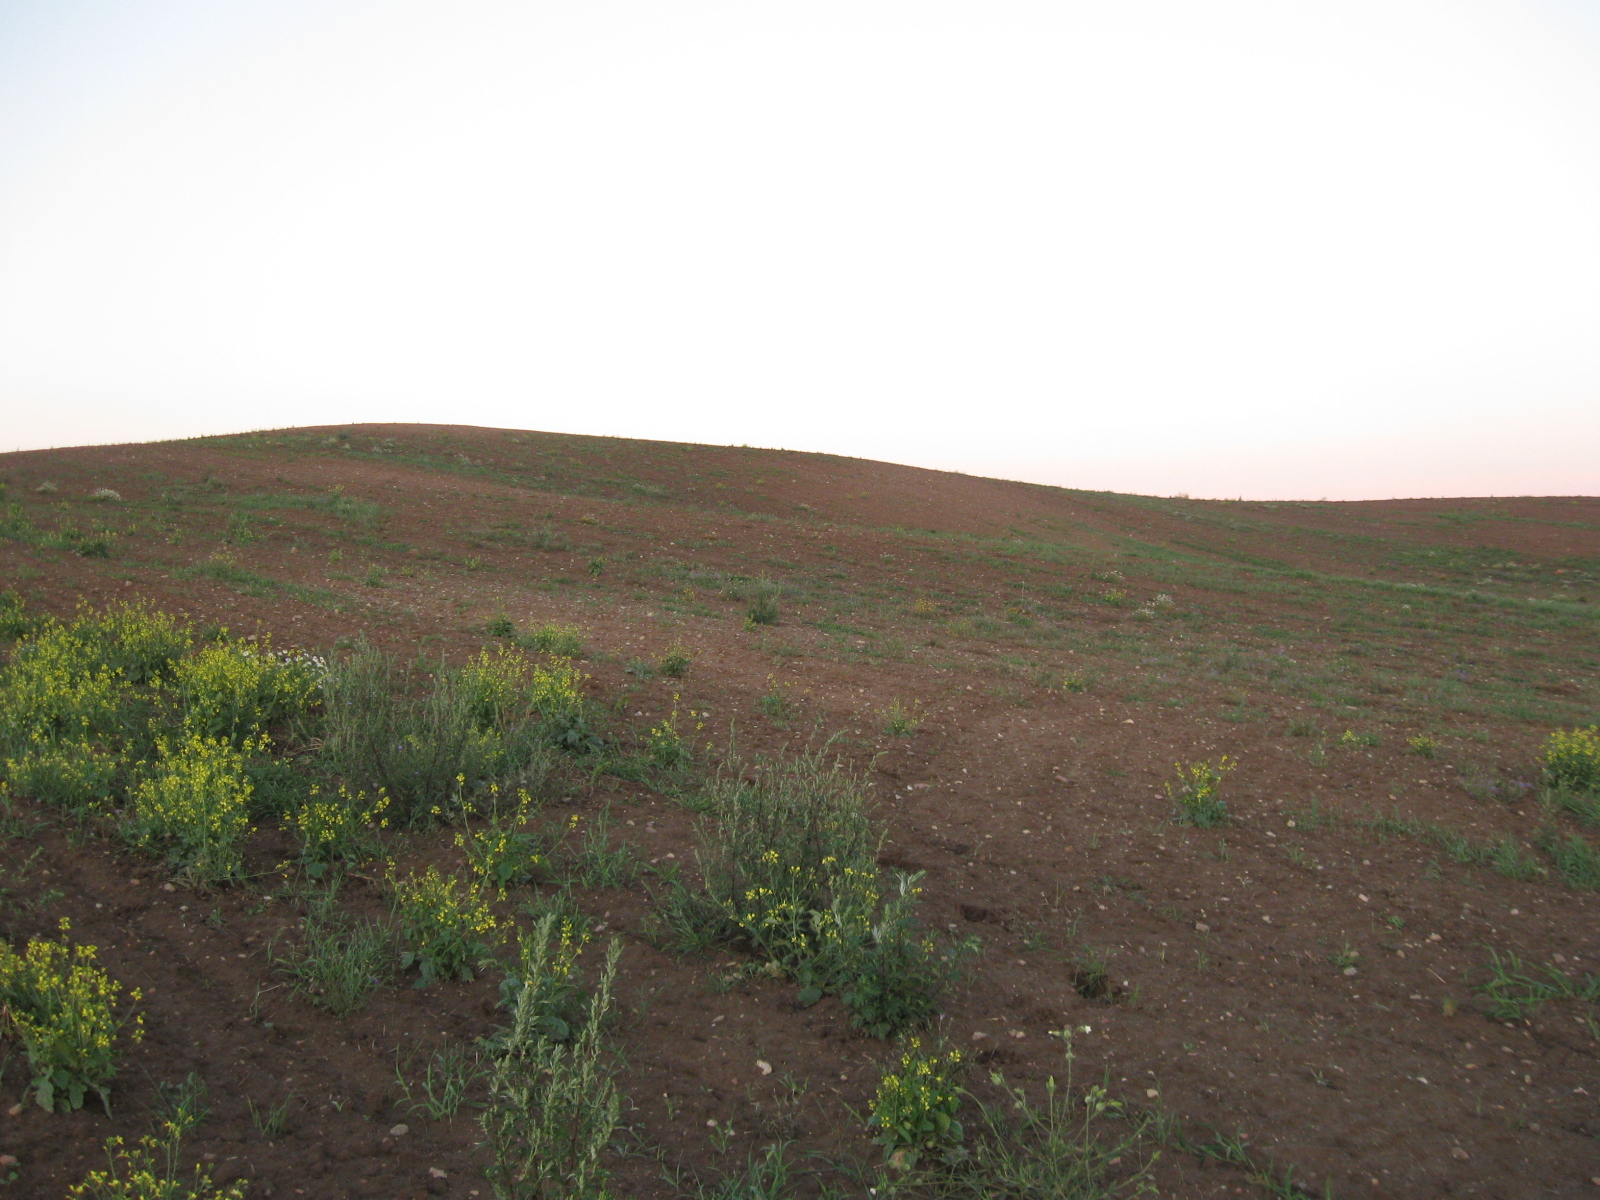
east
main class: Grassland
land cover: Spontaneously vegetated surfaces
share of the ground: 10 - 25 %
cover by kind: unconsolidated bare surface 80 %, herbaceous plants 20 %
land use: Agriculture (excluding fallow land and kitchen gardens)
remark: Tilled/Sowed
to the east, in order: Spontaneously vegetated surfaces; Grassland without tree/shrub cover
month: July
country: LT
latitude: 54.1098
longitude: 23.7469
